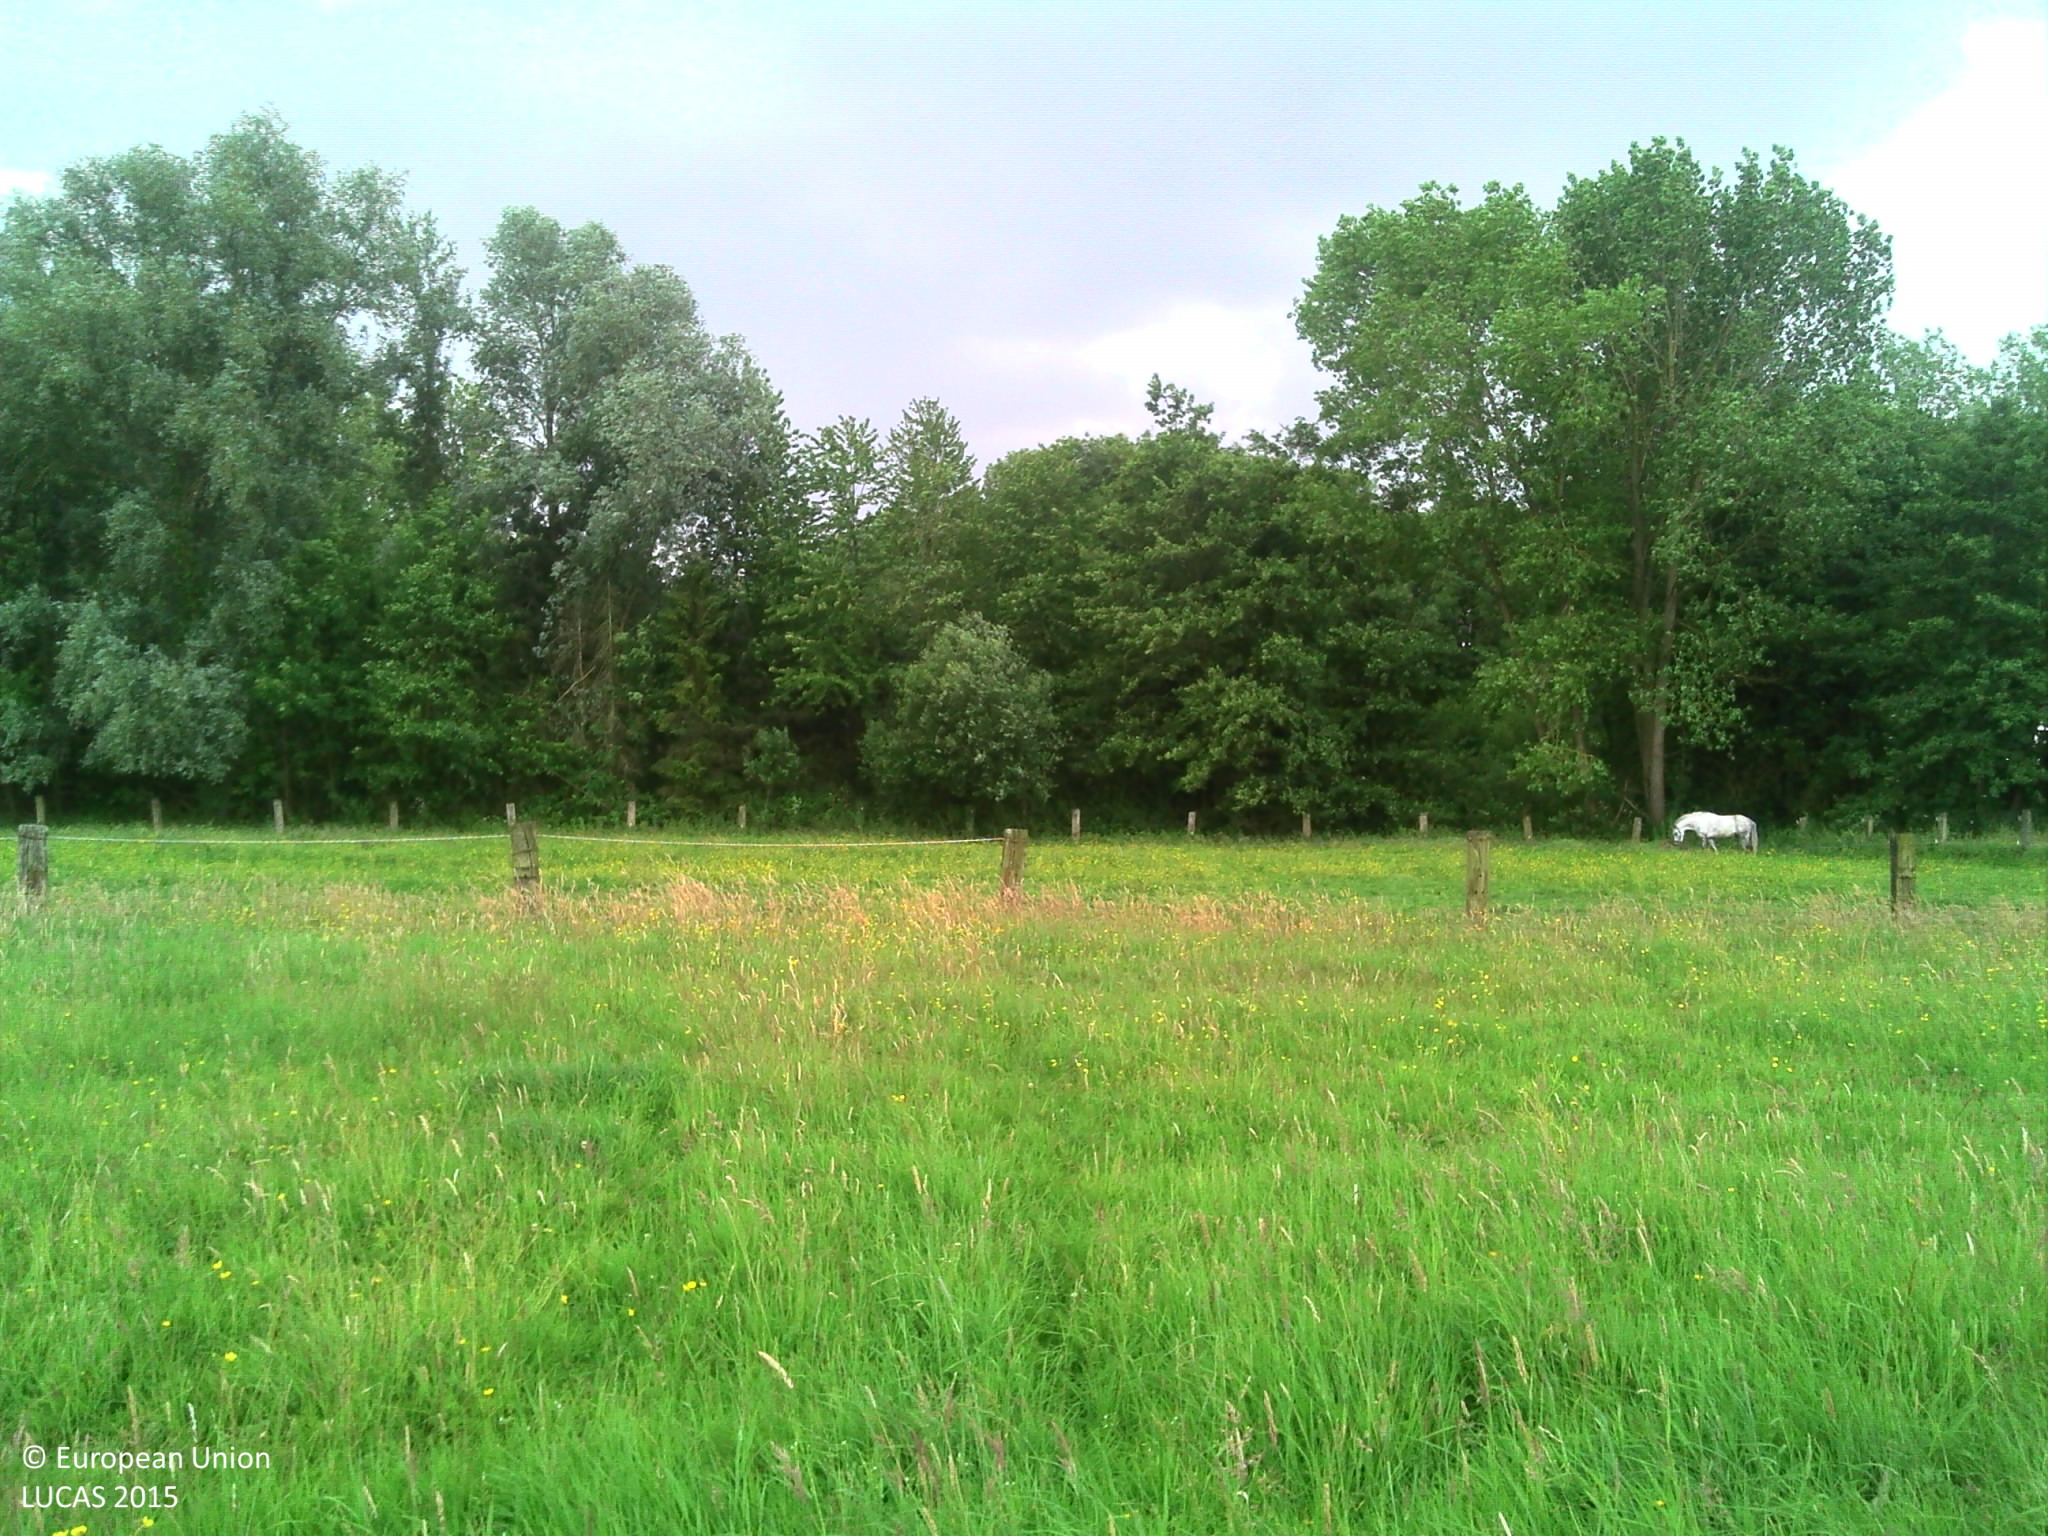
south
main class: Grassland
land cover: Grassland without tree/shrub cover
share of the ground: > 75 %
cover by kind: herbaceous plants 100 %
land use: Agriculture (excluding fallow land and kitchen gardens)
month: June
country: BE
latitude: 50.9851
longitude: 4.4257
